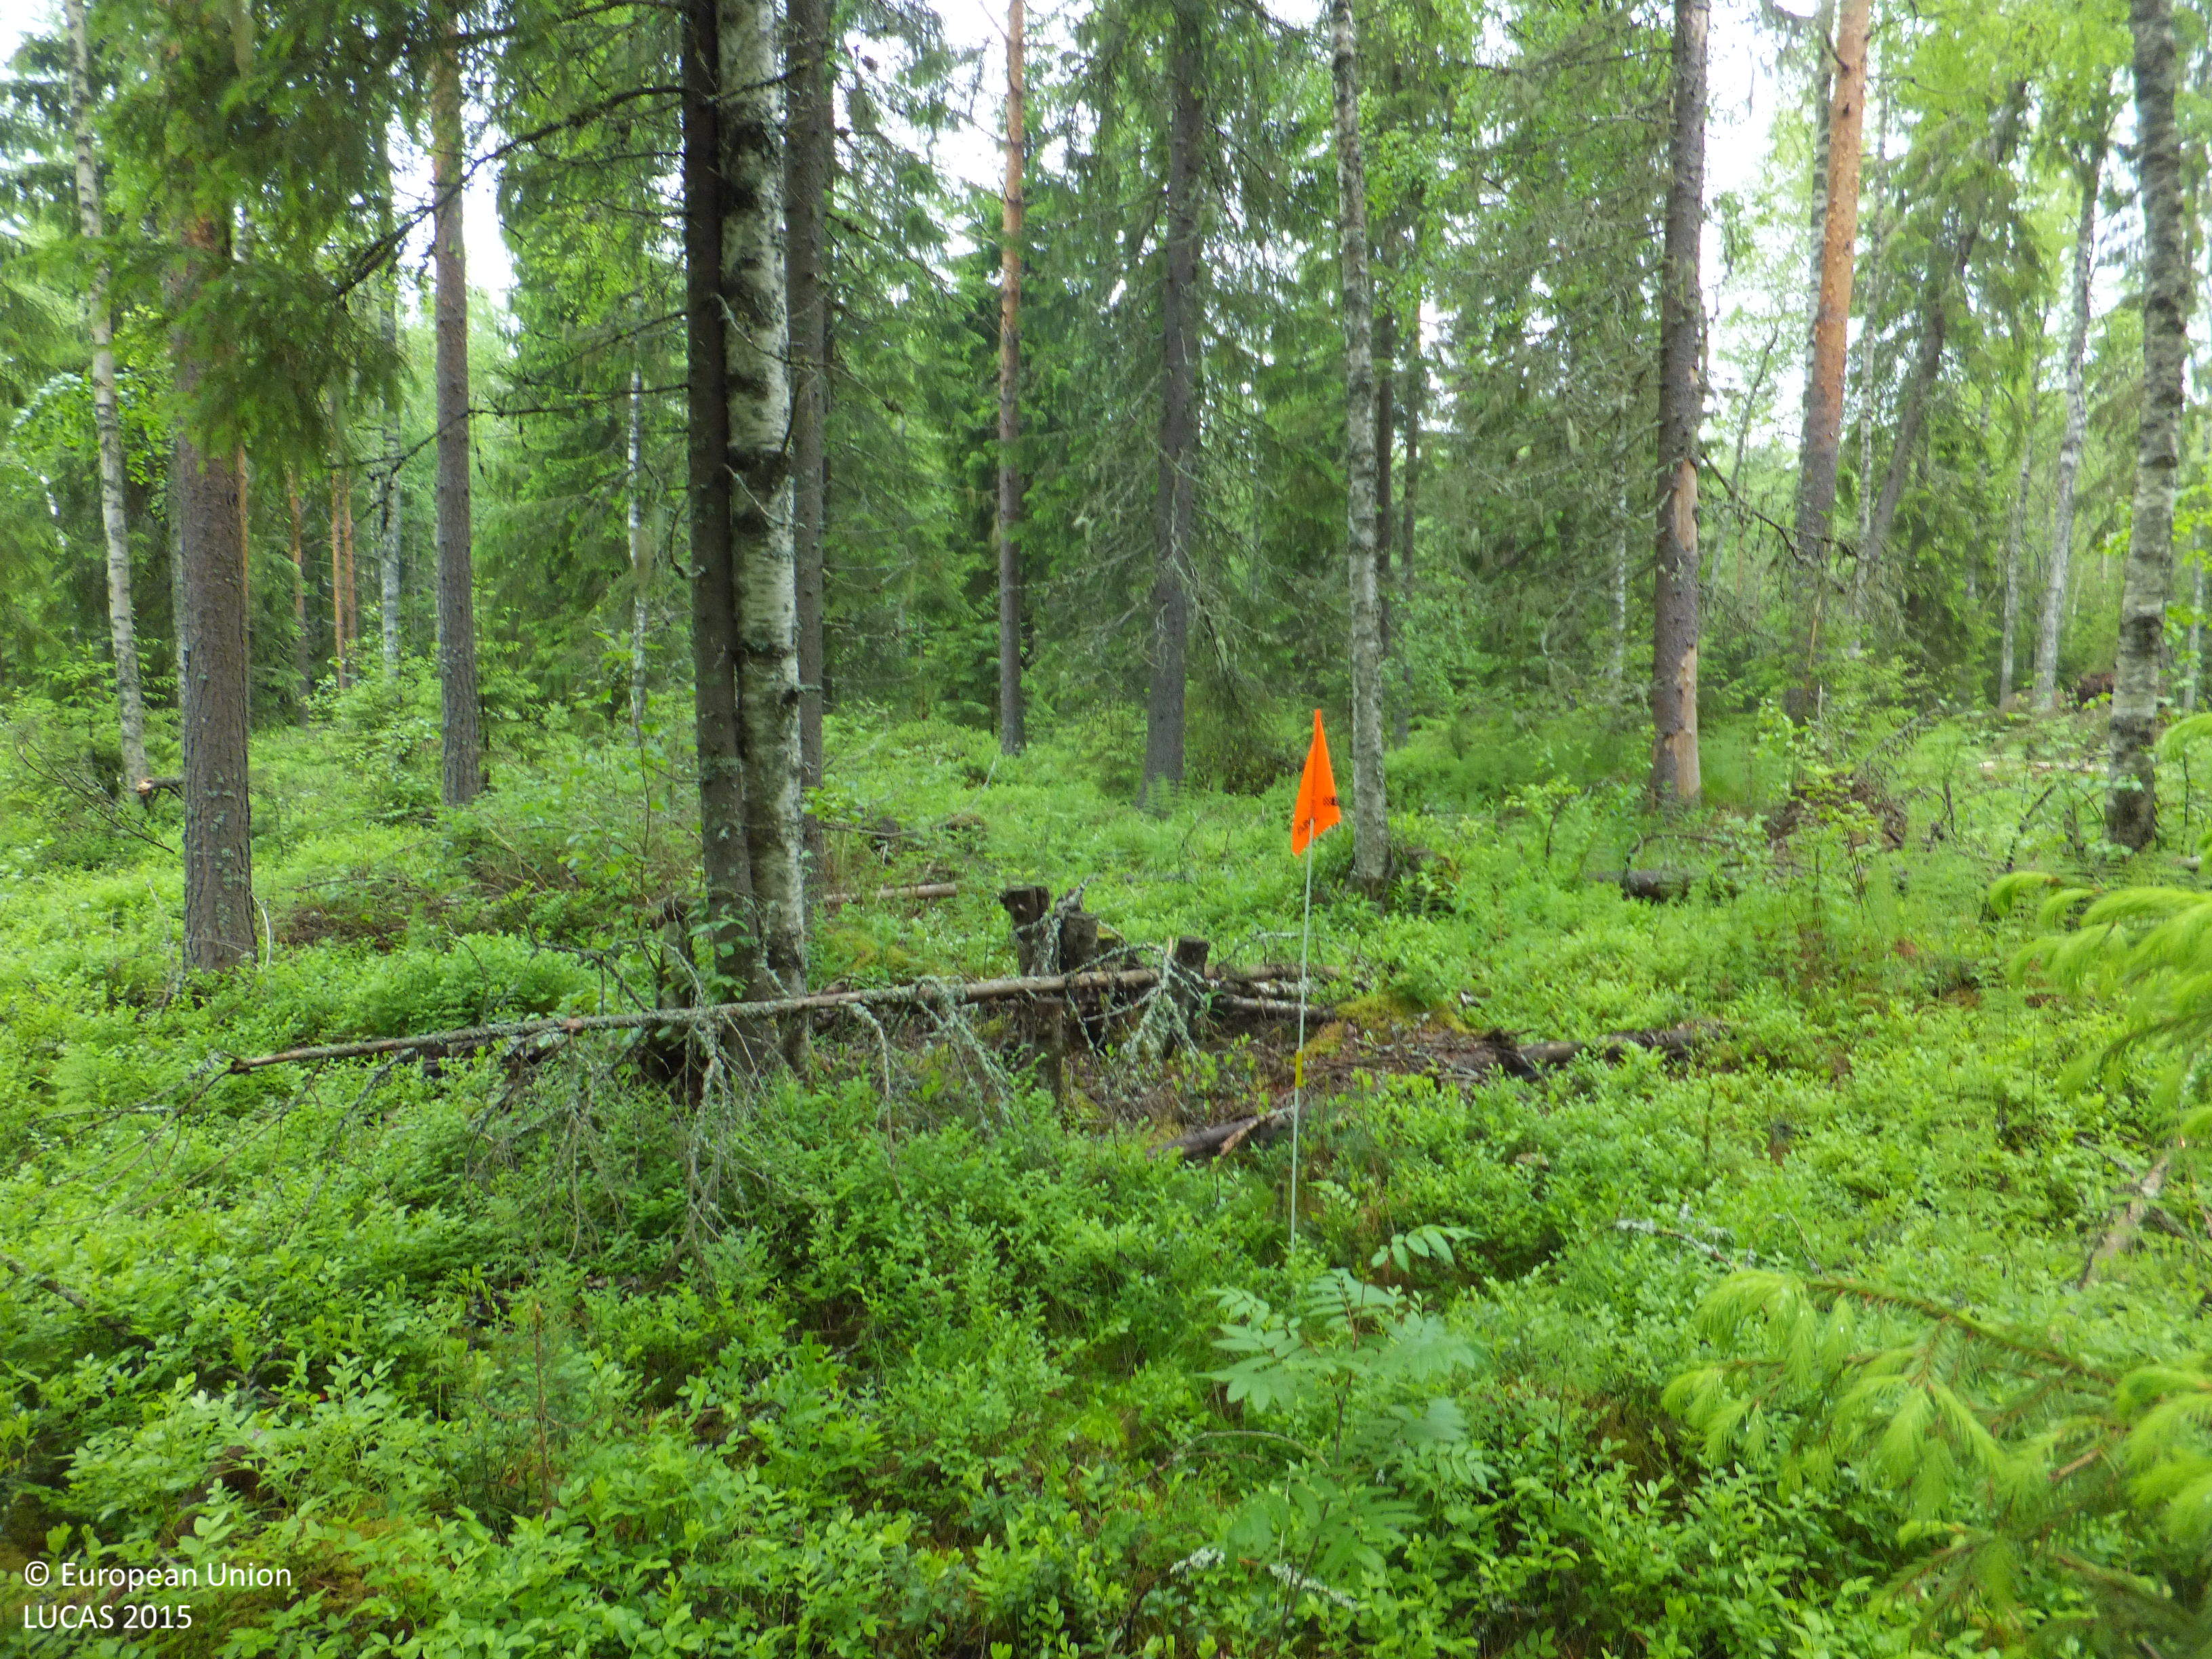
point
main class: Woodland
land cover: Other mixed woodland
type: boreal forest
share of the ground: > 75 %
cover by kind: coniferous forest trees 50 %, broadleaved forest trees 25 %, shrubs 15 %, lichens and mosses 10 %
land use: Forestry
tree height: > 5 m
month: June
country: FI
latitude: 63.4316
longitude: 23.9173
